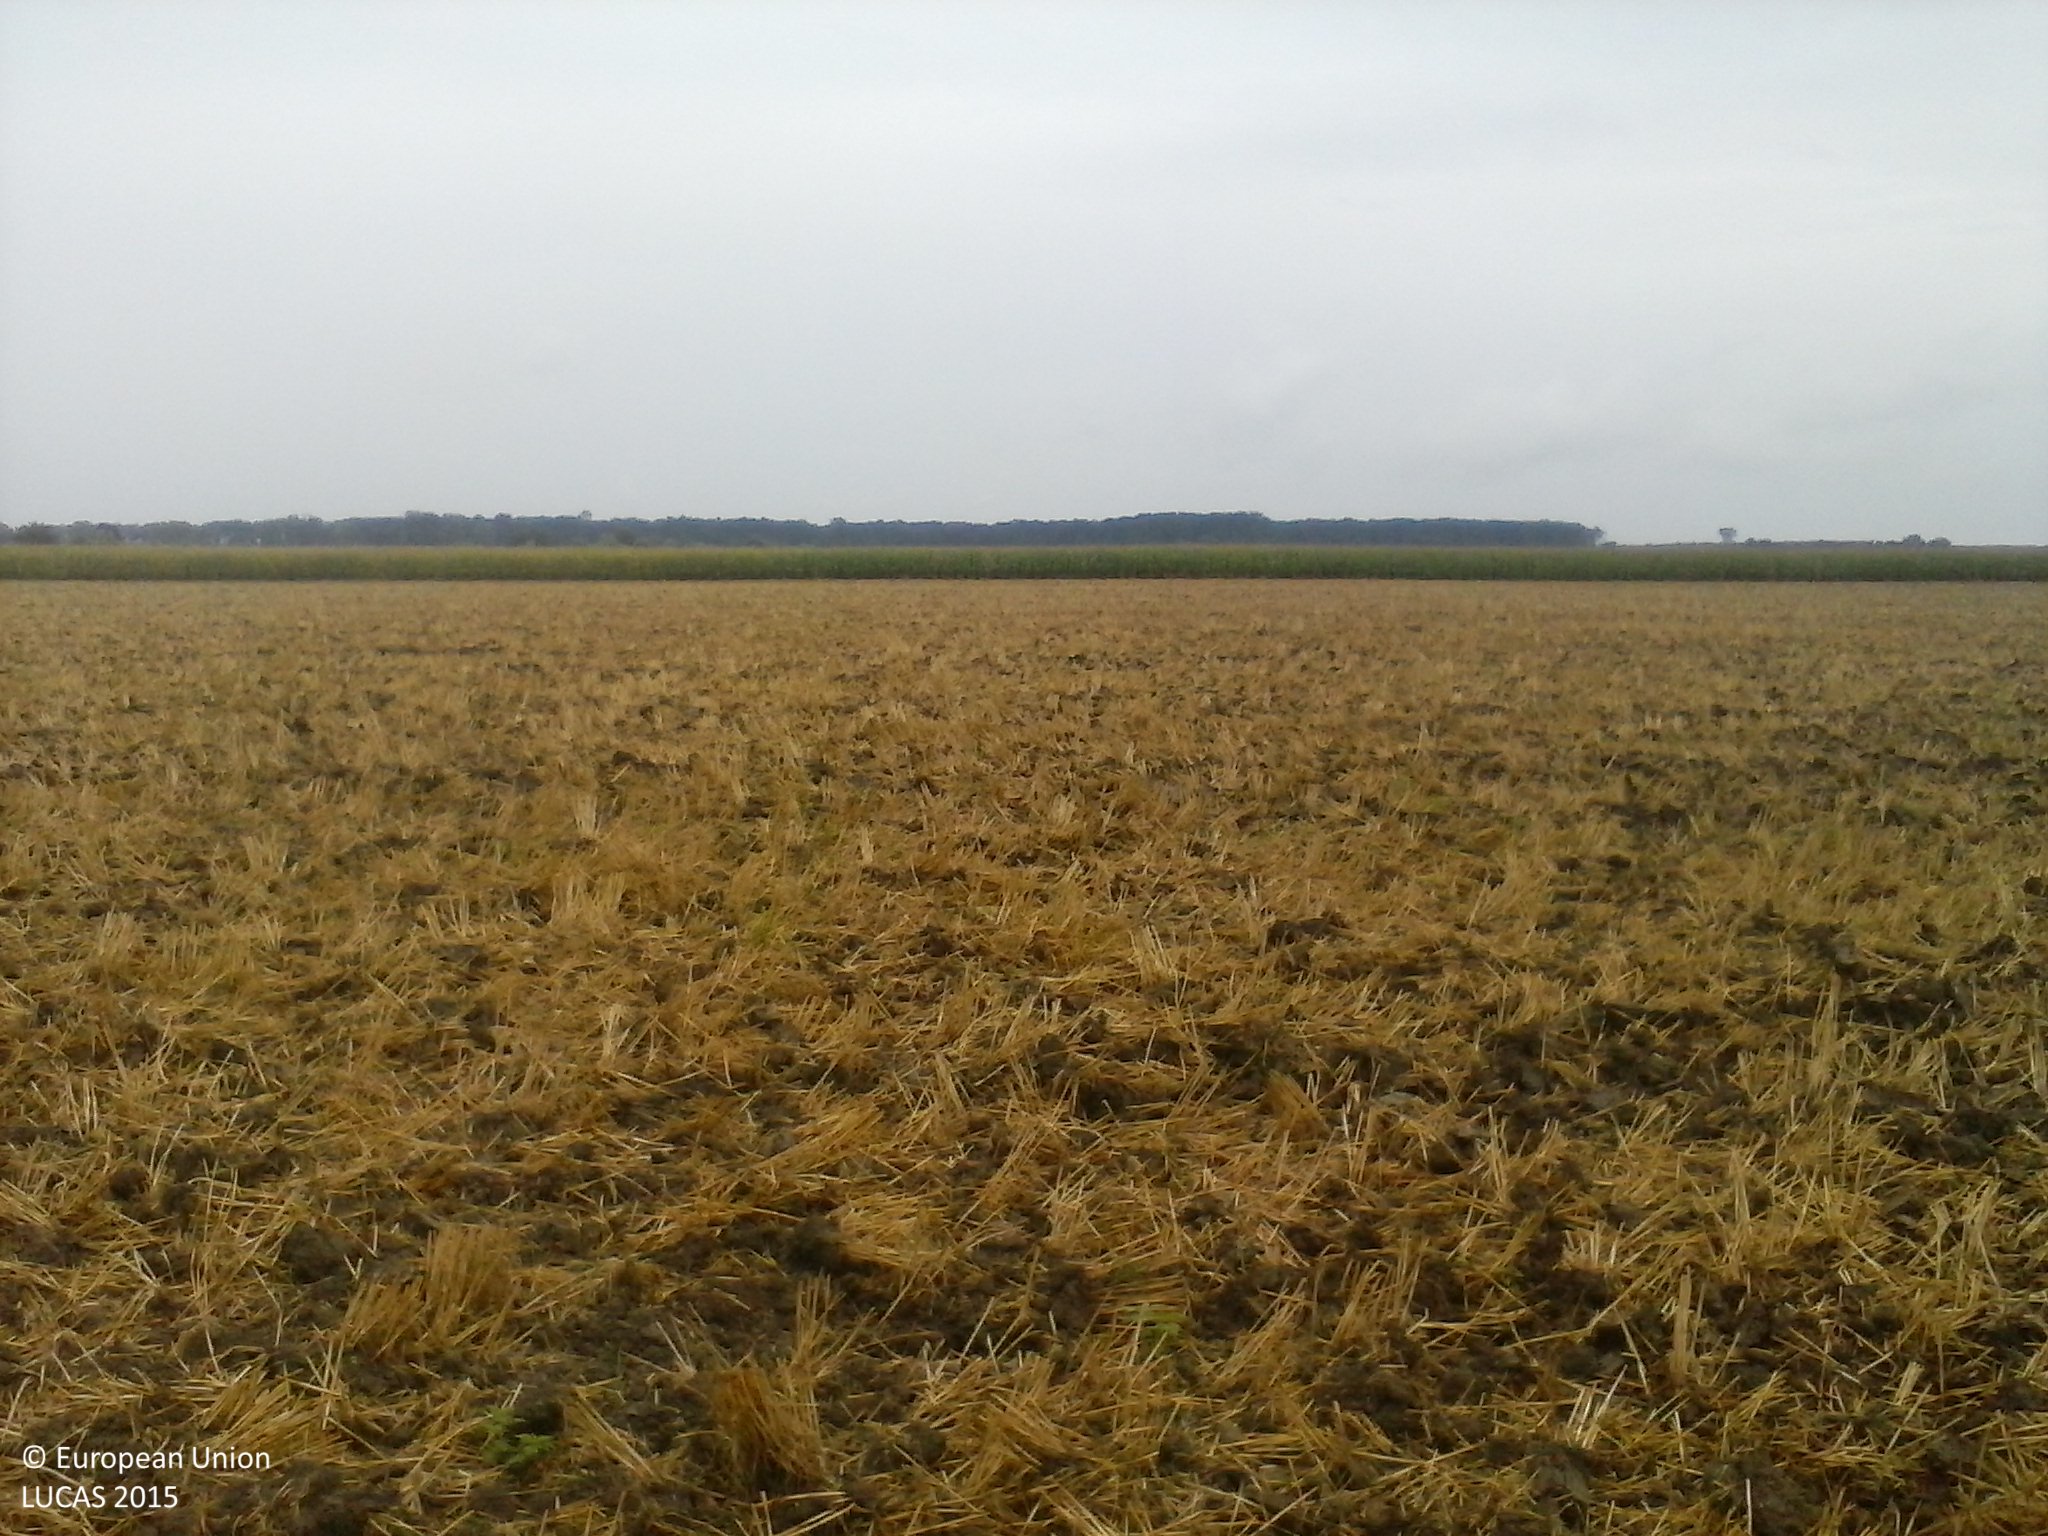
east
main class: Cropland
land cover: Common wheat
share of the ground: 50 - 75 %
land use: Agriculture (excluding fallow land and kitchen gardens)
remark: Harvested field
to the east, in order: Common wheat; Maize; Grass margins; Abandoned hedges; Grass margins; Tracks
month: July
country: HU
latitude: 45.9161
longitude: 17.6233
